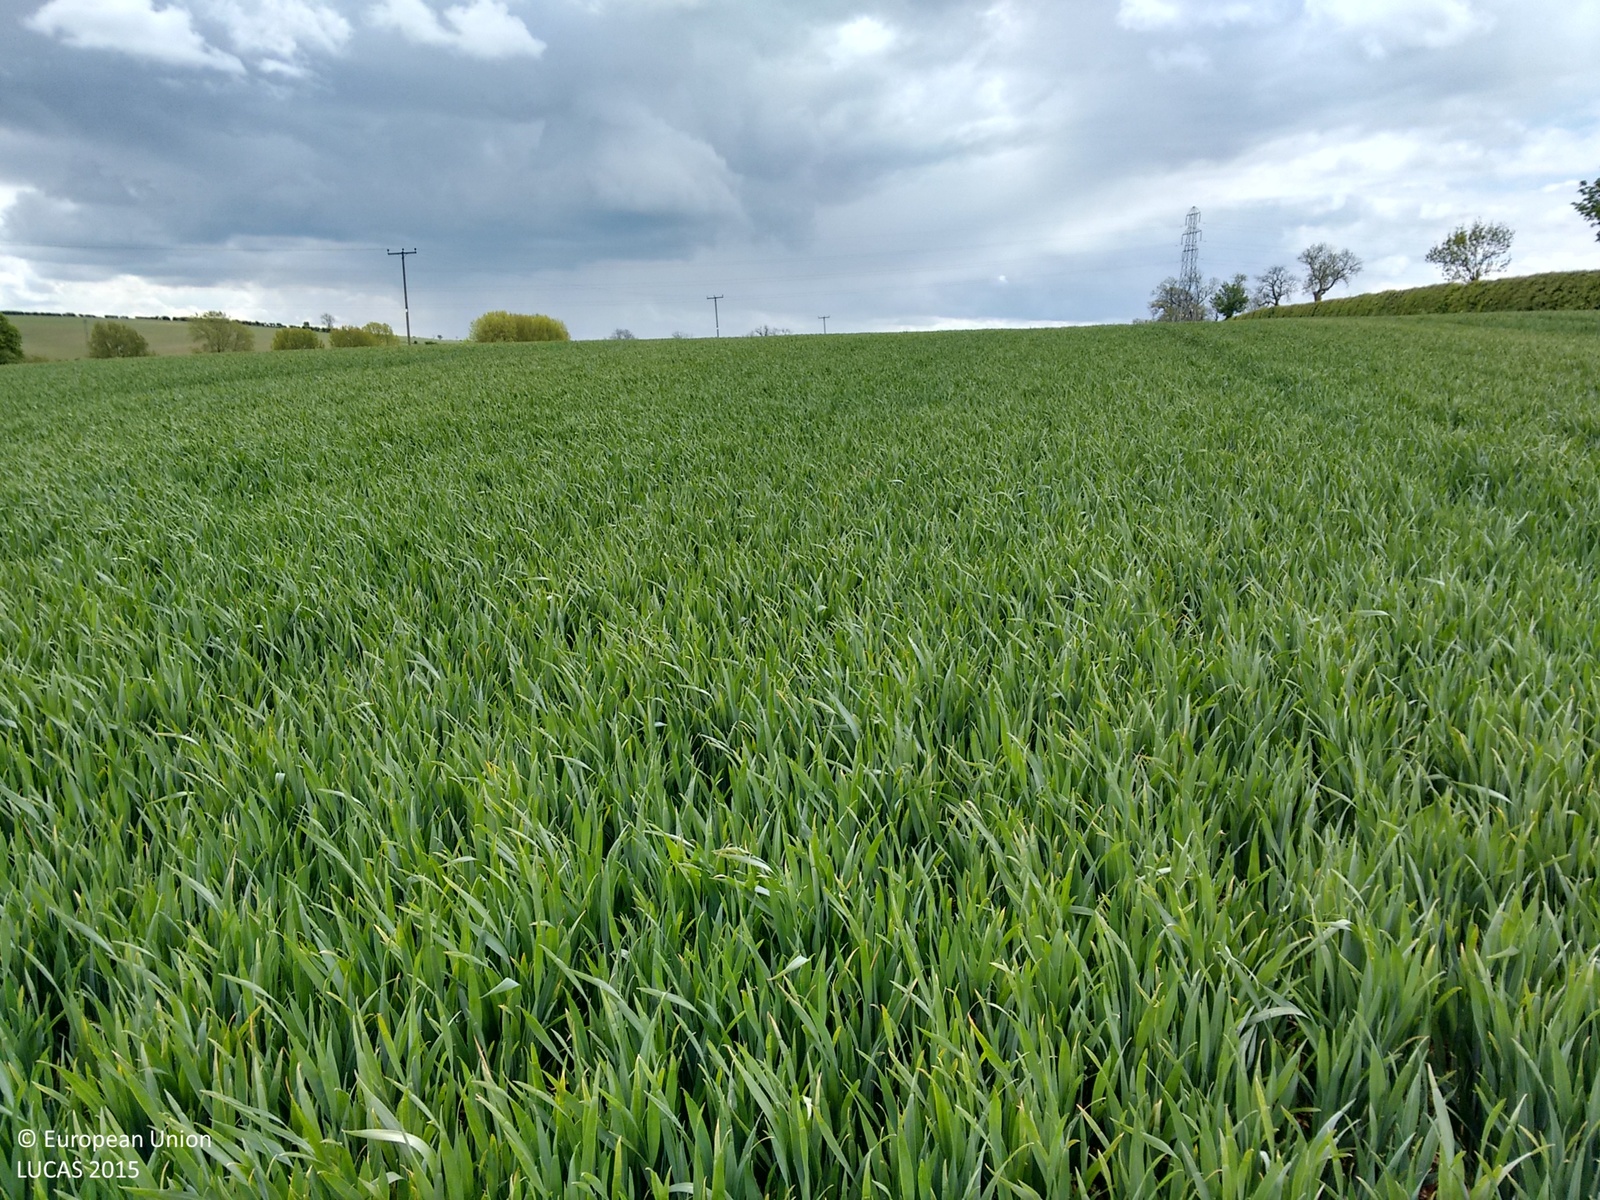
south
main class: Cropland
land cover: Common wheat
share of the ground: > 75 %
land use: Agriculture (excluding fallow land and kitchen gardens)
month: May
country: GB
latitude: 53.4773
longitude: -0.2044
